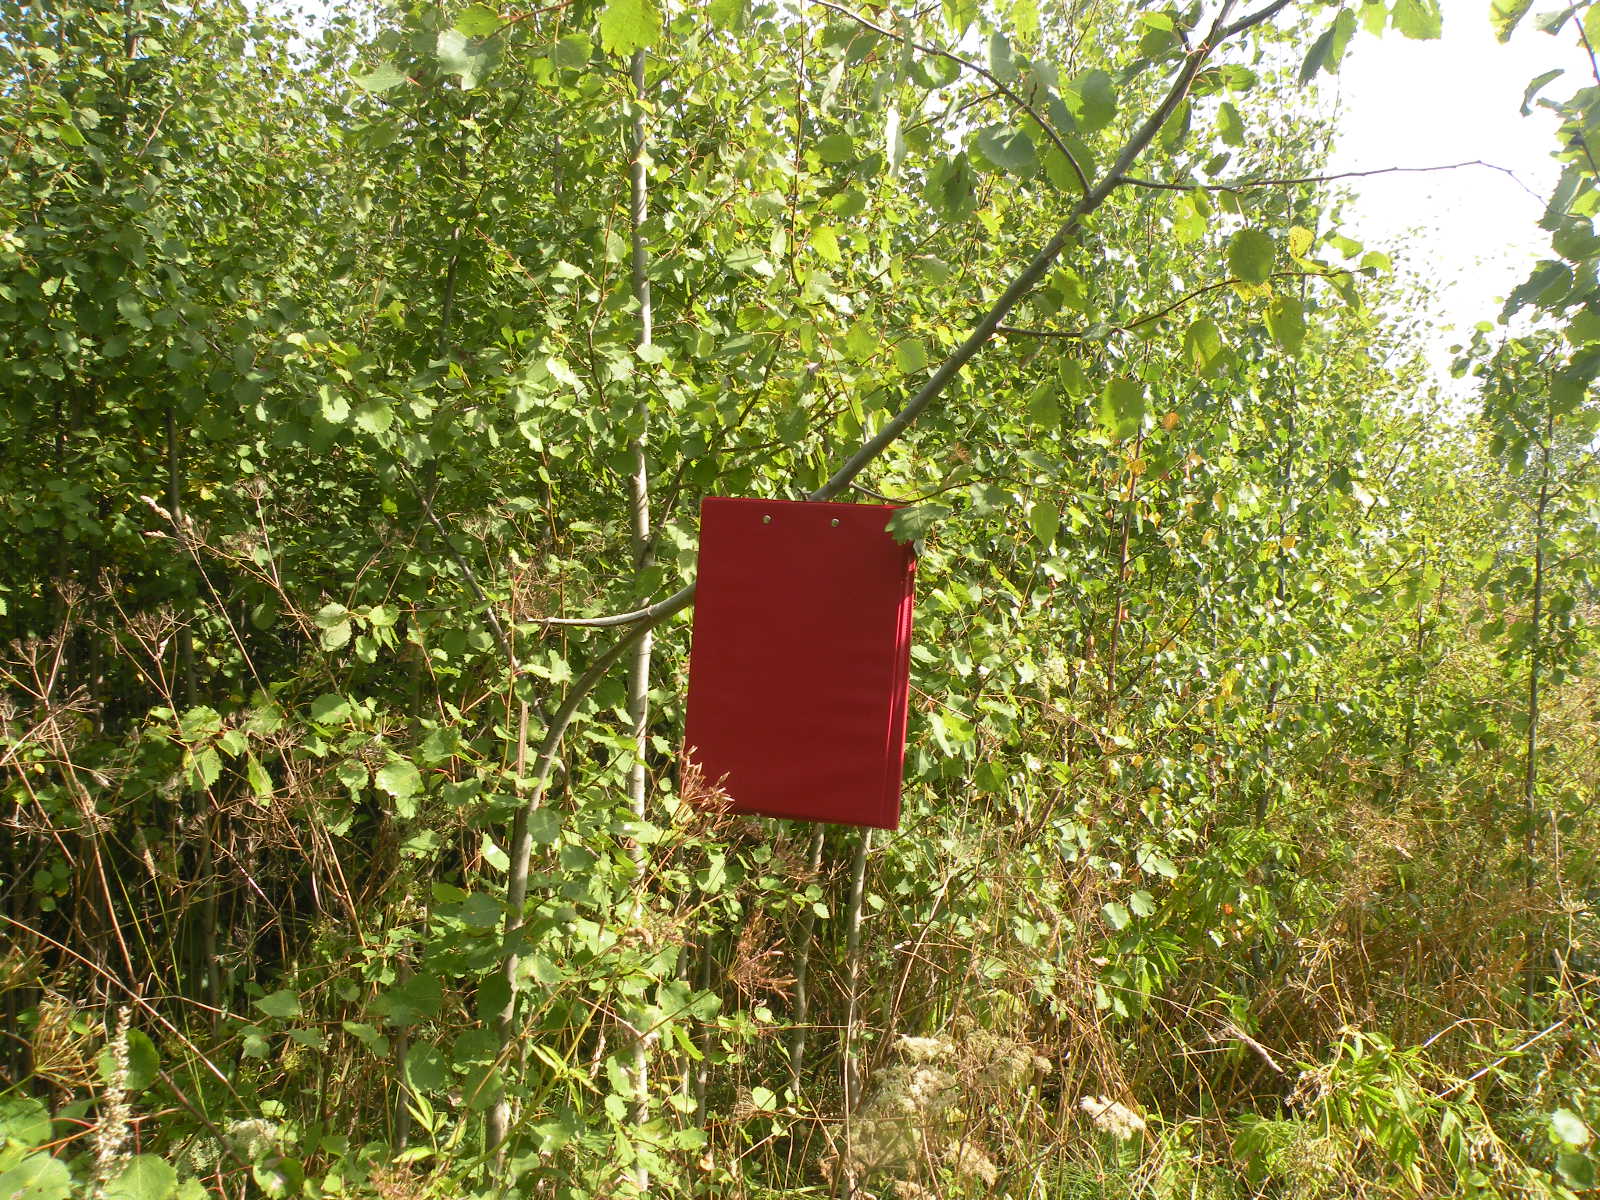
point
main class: Woodland
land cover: Broadleaved woodland
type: non-riverine alder, birch or aspen forest
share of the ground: > 75 %
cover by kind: broadleaved forest trees 75 %, herbaceous plants 15 %, shrubs 10 %
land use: Forestry
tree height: > 5 m
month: August
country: LV
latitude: 55.8689
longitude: 26.1697
